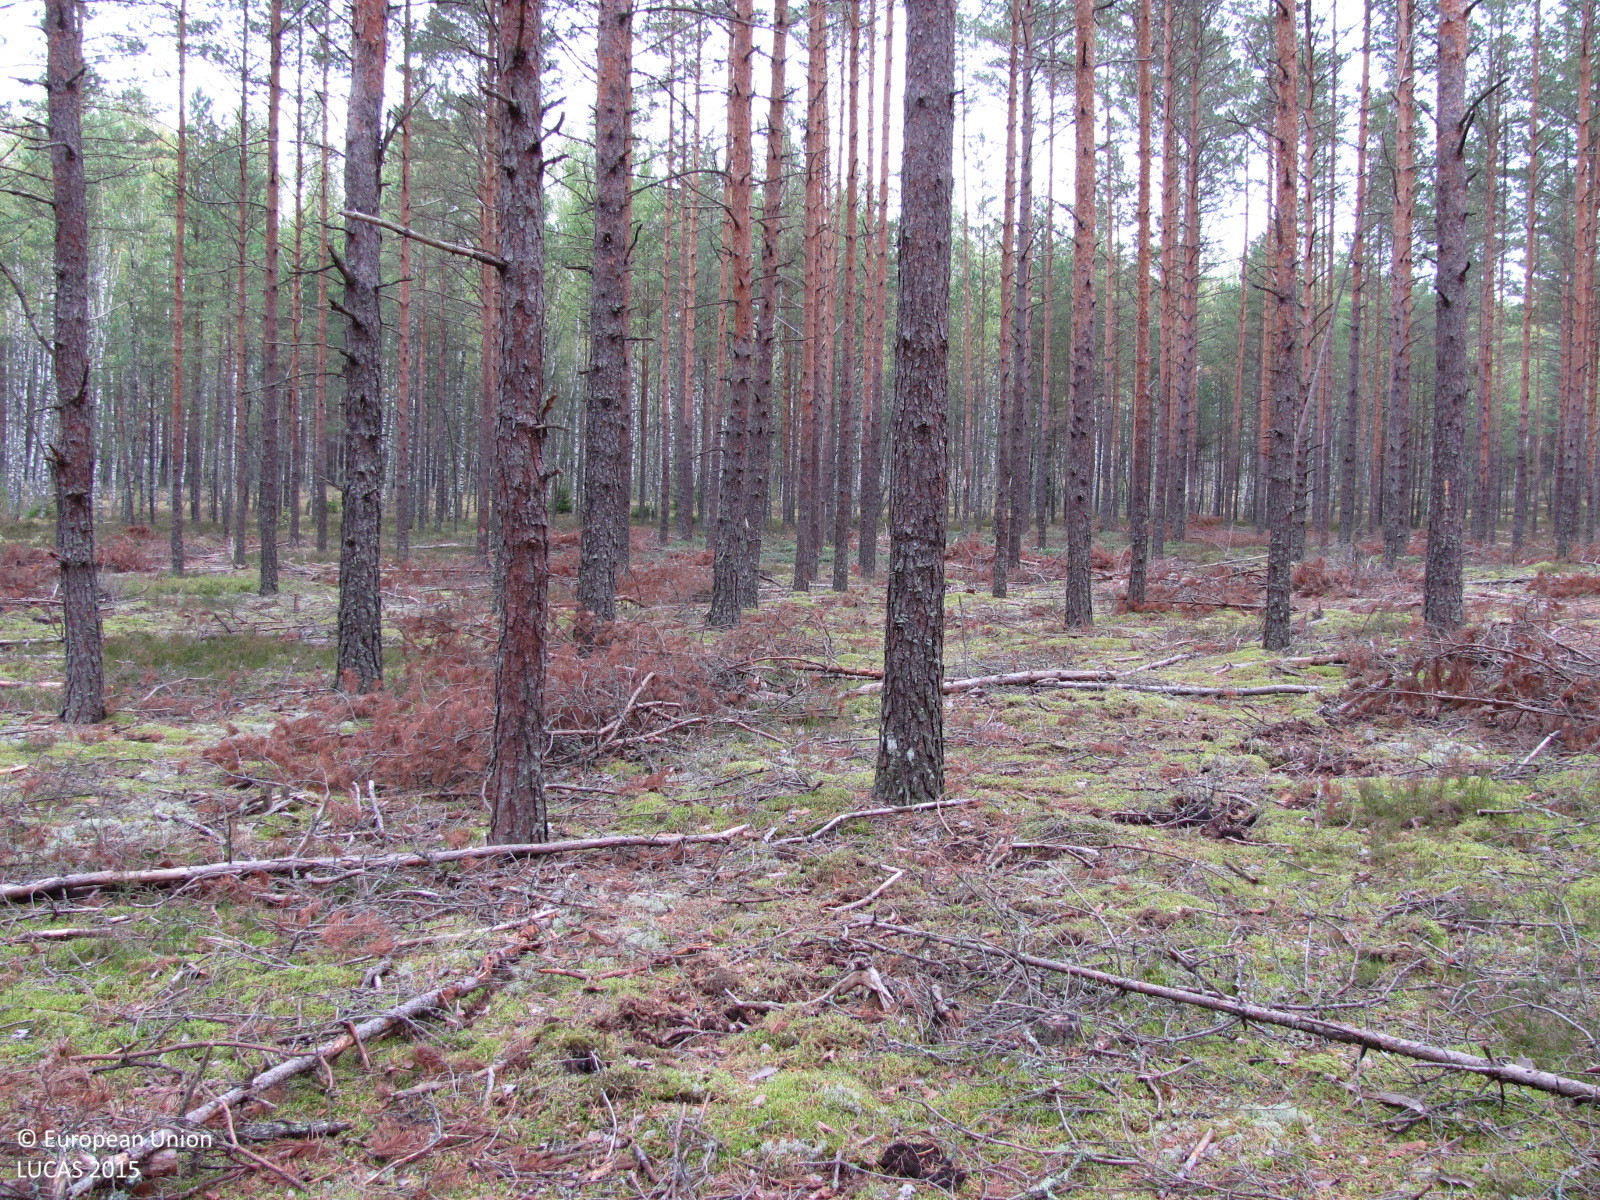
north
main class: Woodland
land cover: Pine dominated coniferous woodland
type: hemiboreal forest and nemoral coniferous forest and mixed broadleaved-coniferous forest
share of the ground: > 75 %
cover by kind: coniferous forest trees 80 %, lichens and mosses 15 %, herbaceous plants 5 %
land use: Forestry
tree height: > 5 m
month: September
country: LV
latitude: 57.0759
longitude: 24.5281
